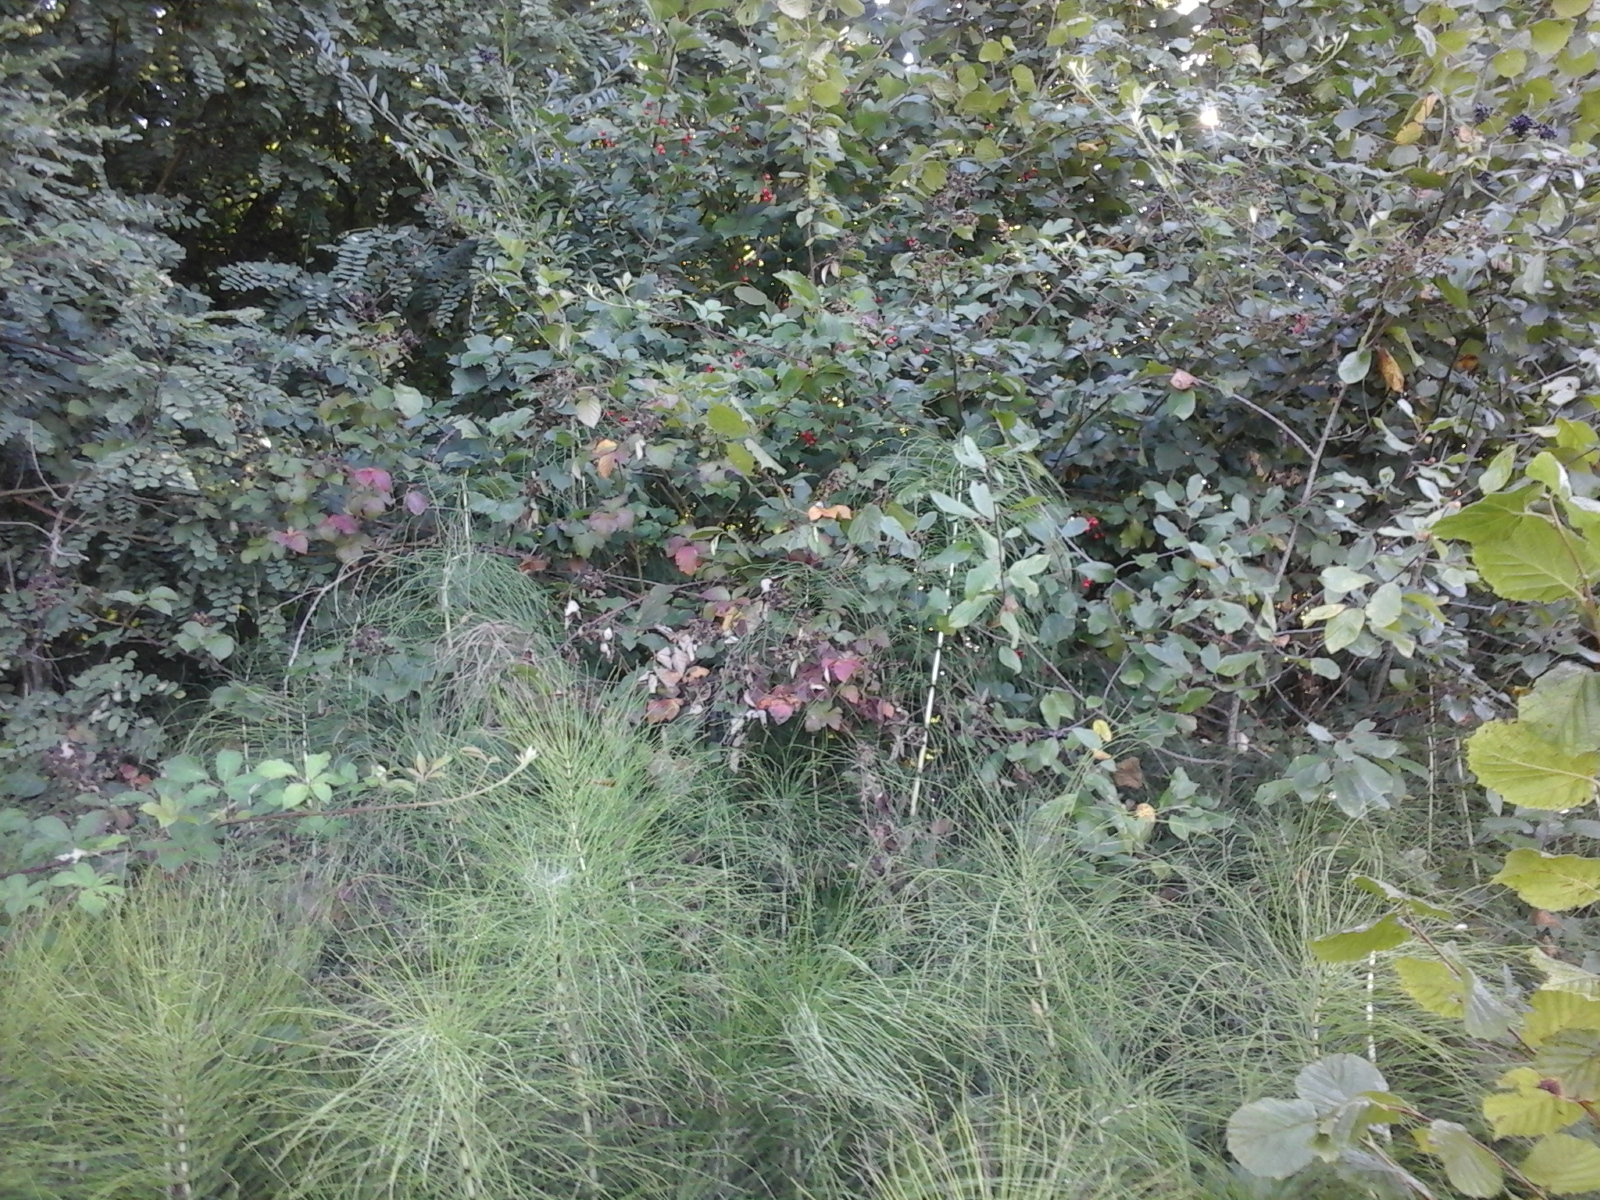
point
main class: Woodland
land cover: Broadleaved woodland
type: exotic forest
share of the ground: > 75 %
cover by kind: broadleaved forest trees 100 %
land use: Forestry
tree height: > 5 m
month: September
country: RO
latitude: 46.6169
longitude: 22.4966
